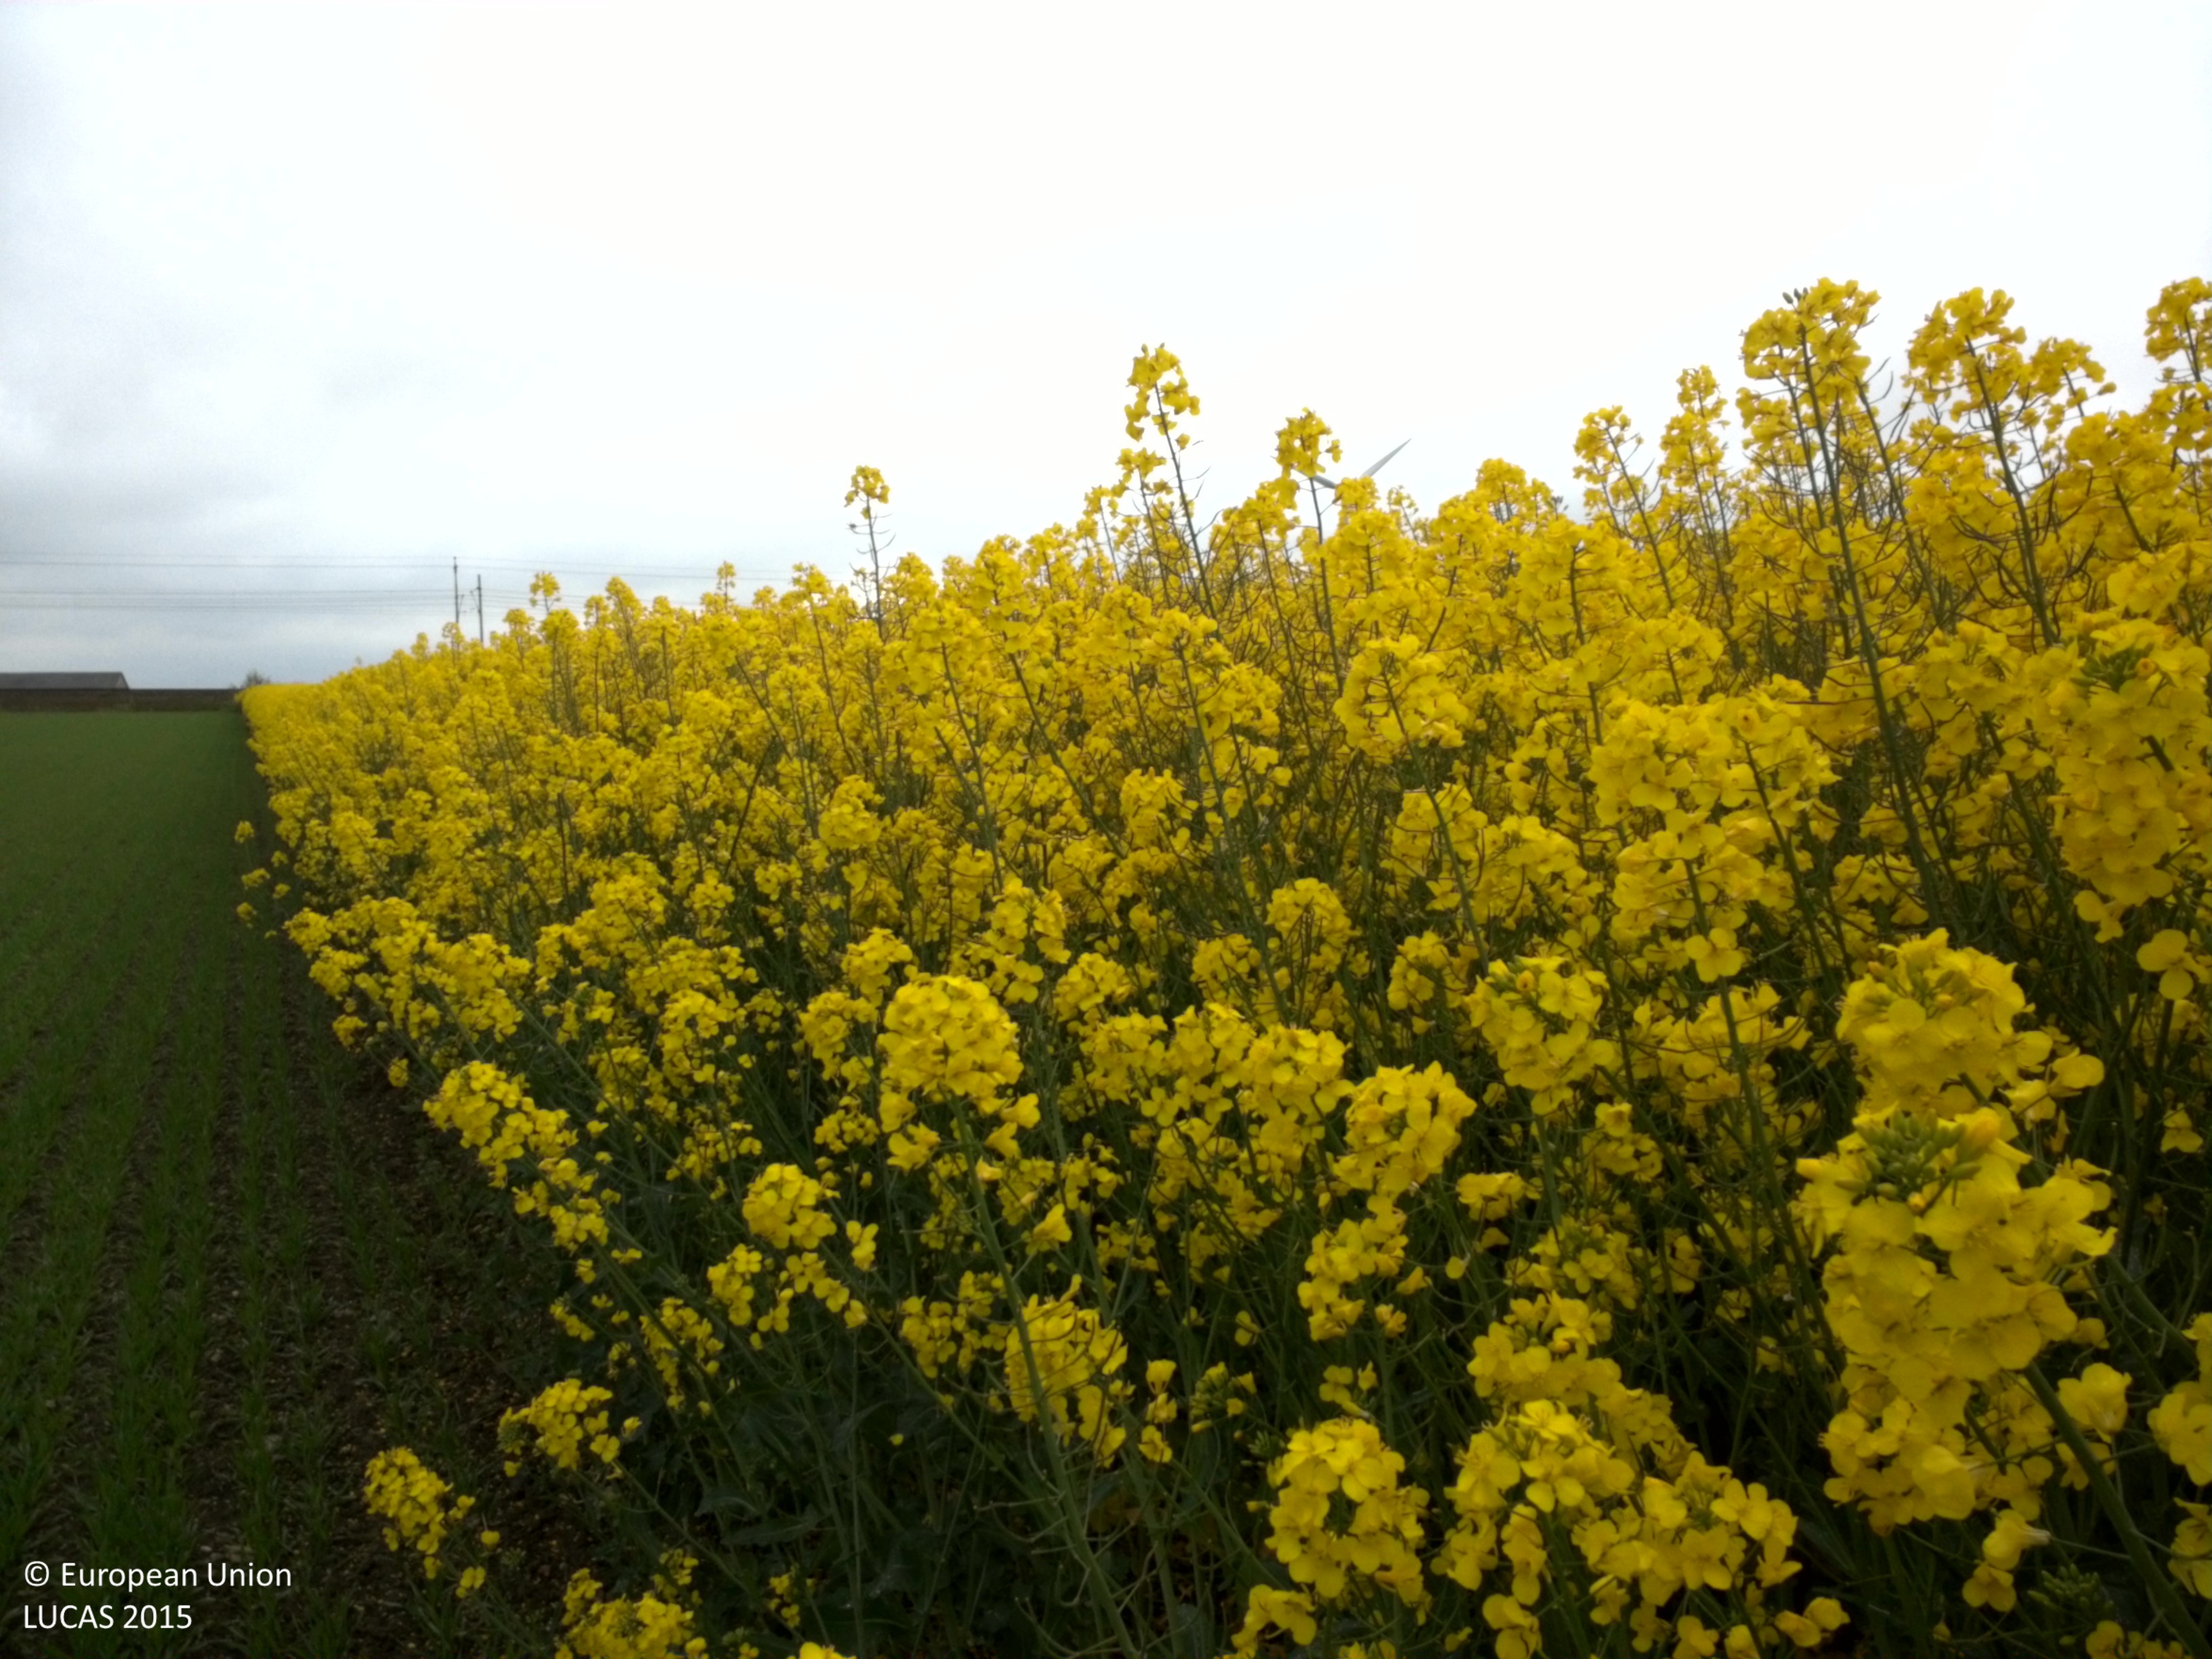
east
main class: Cropland
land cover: Rape and turnip rape
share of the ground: > 75 %
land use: Agriculture (excluding fallow land and kitchen gardens)
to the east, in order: Rape and turnip rape; Grass margins; Lines of trees; Ditches and canals; Grass margins; Electric lines; Railways; Electric lines; Grass margins; Ditches and canals; Tracks; Barley
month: May
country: SE
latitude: 55.7537
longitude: 13.1367
